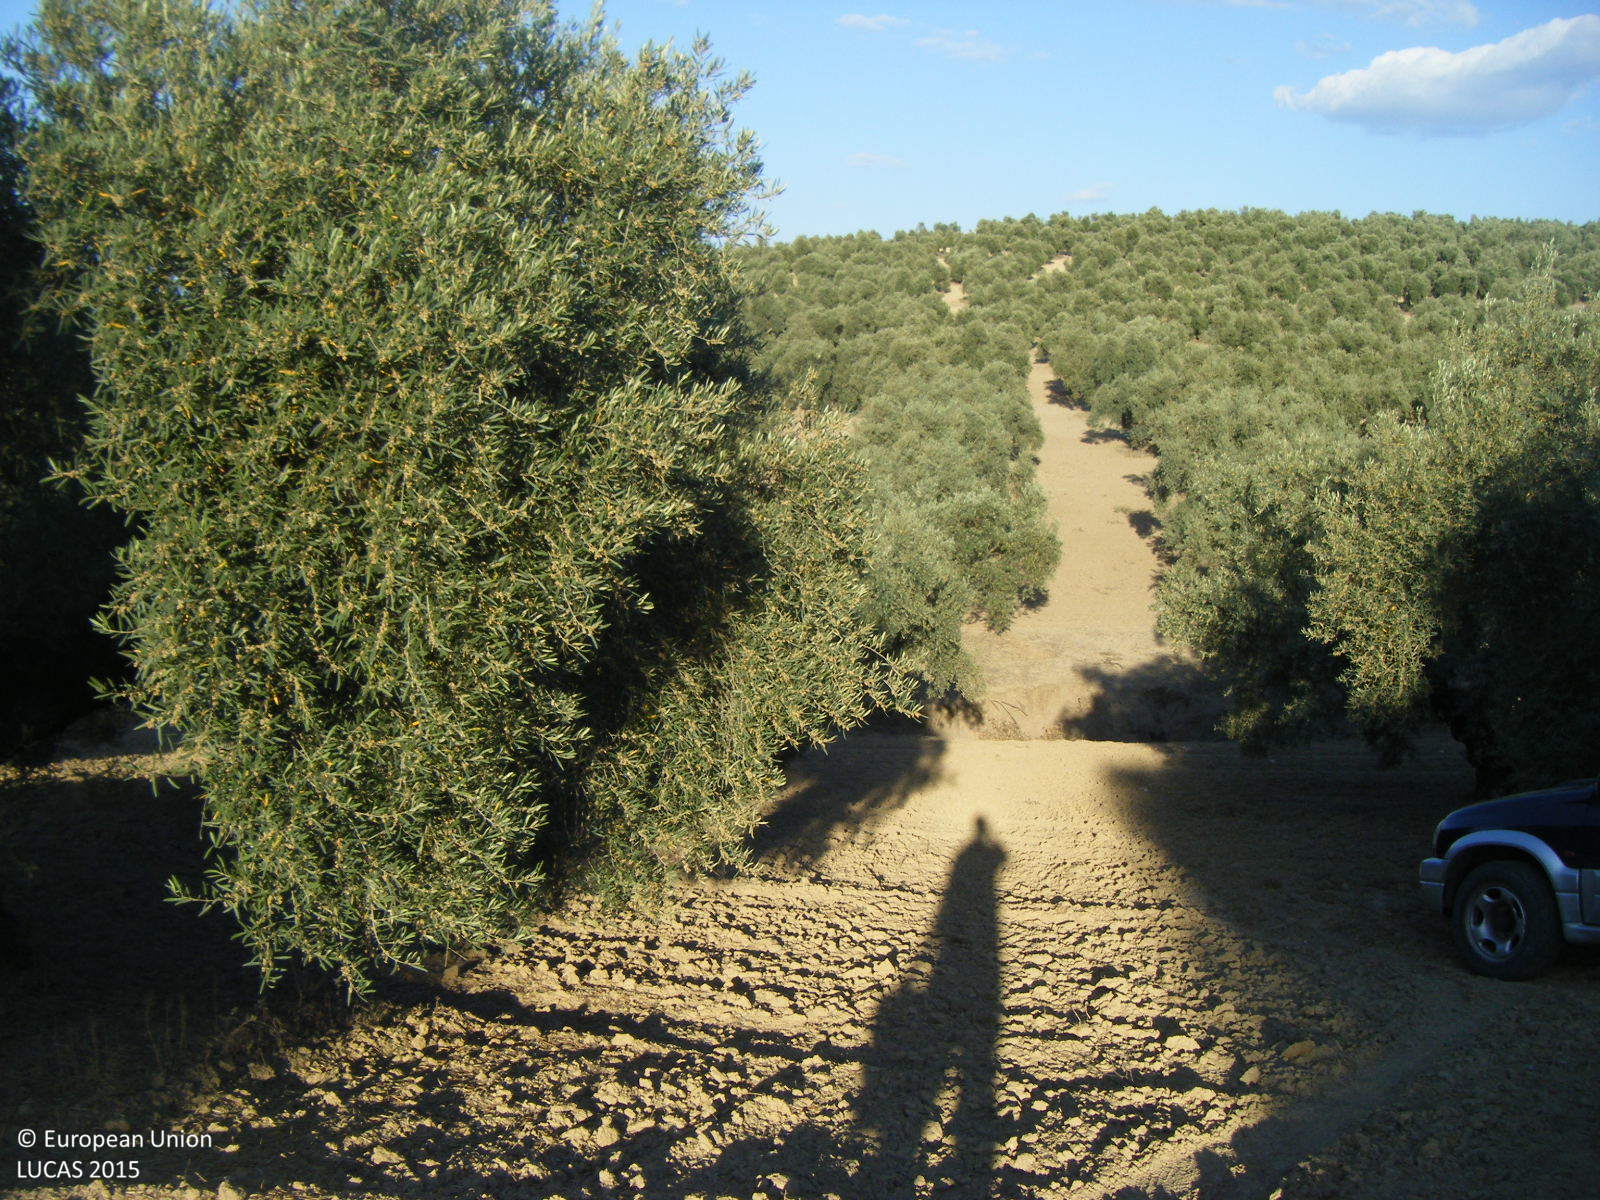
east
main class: Cropland
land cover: Olive groves
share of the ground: 25 - 50 %
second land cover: Other bare soil
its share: > 75 %
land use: Agriculture (excluding fallow land and kitchen gardens)
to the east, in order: Olive groves; Other bare soil; Rivers and streams; Olive groves
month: May
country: ES
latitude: 37.2356
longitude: -4.5068
